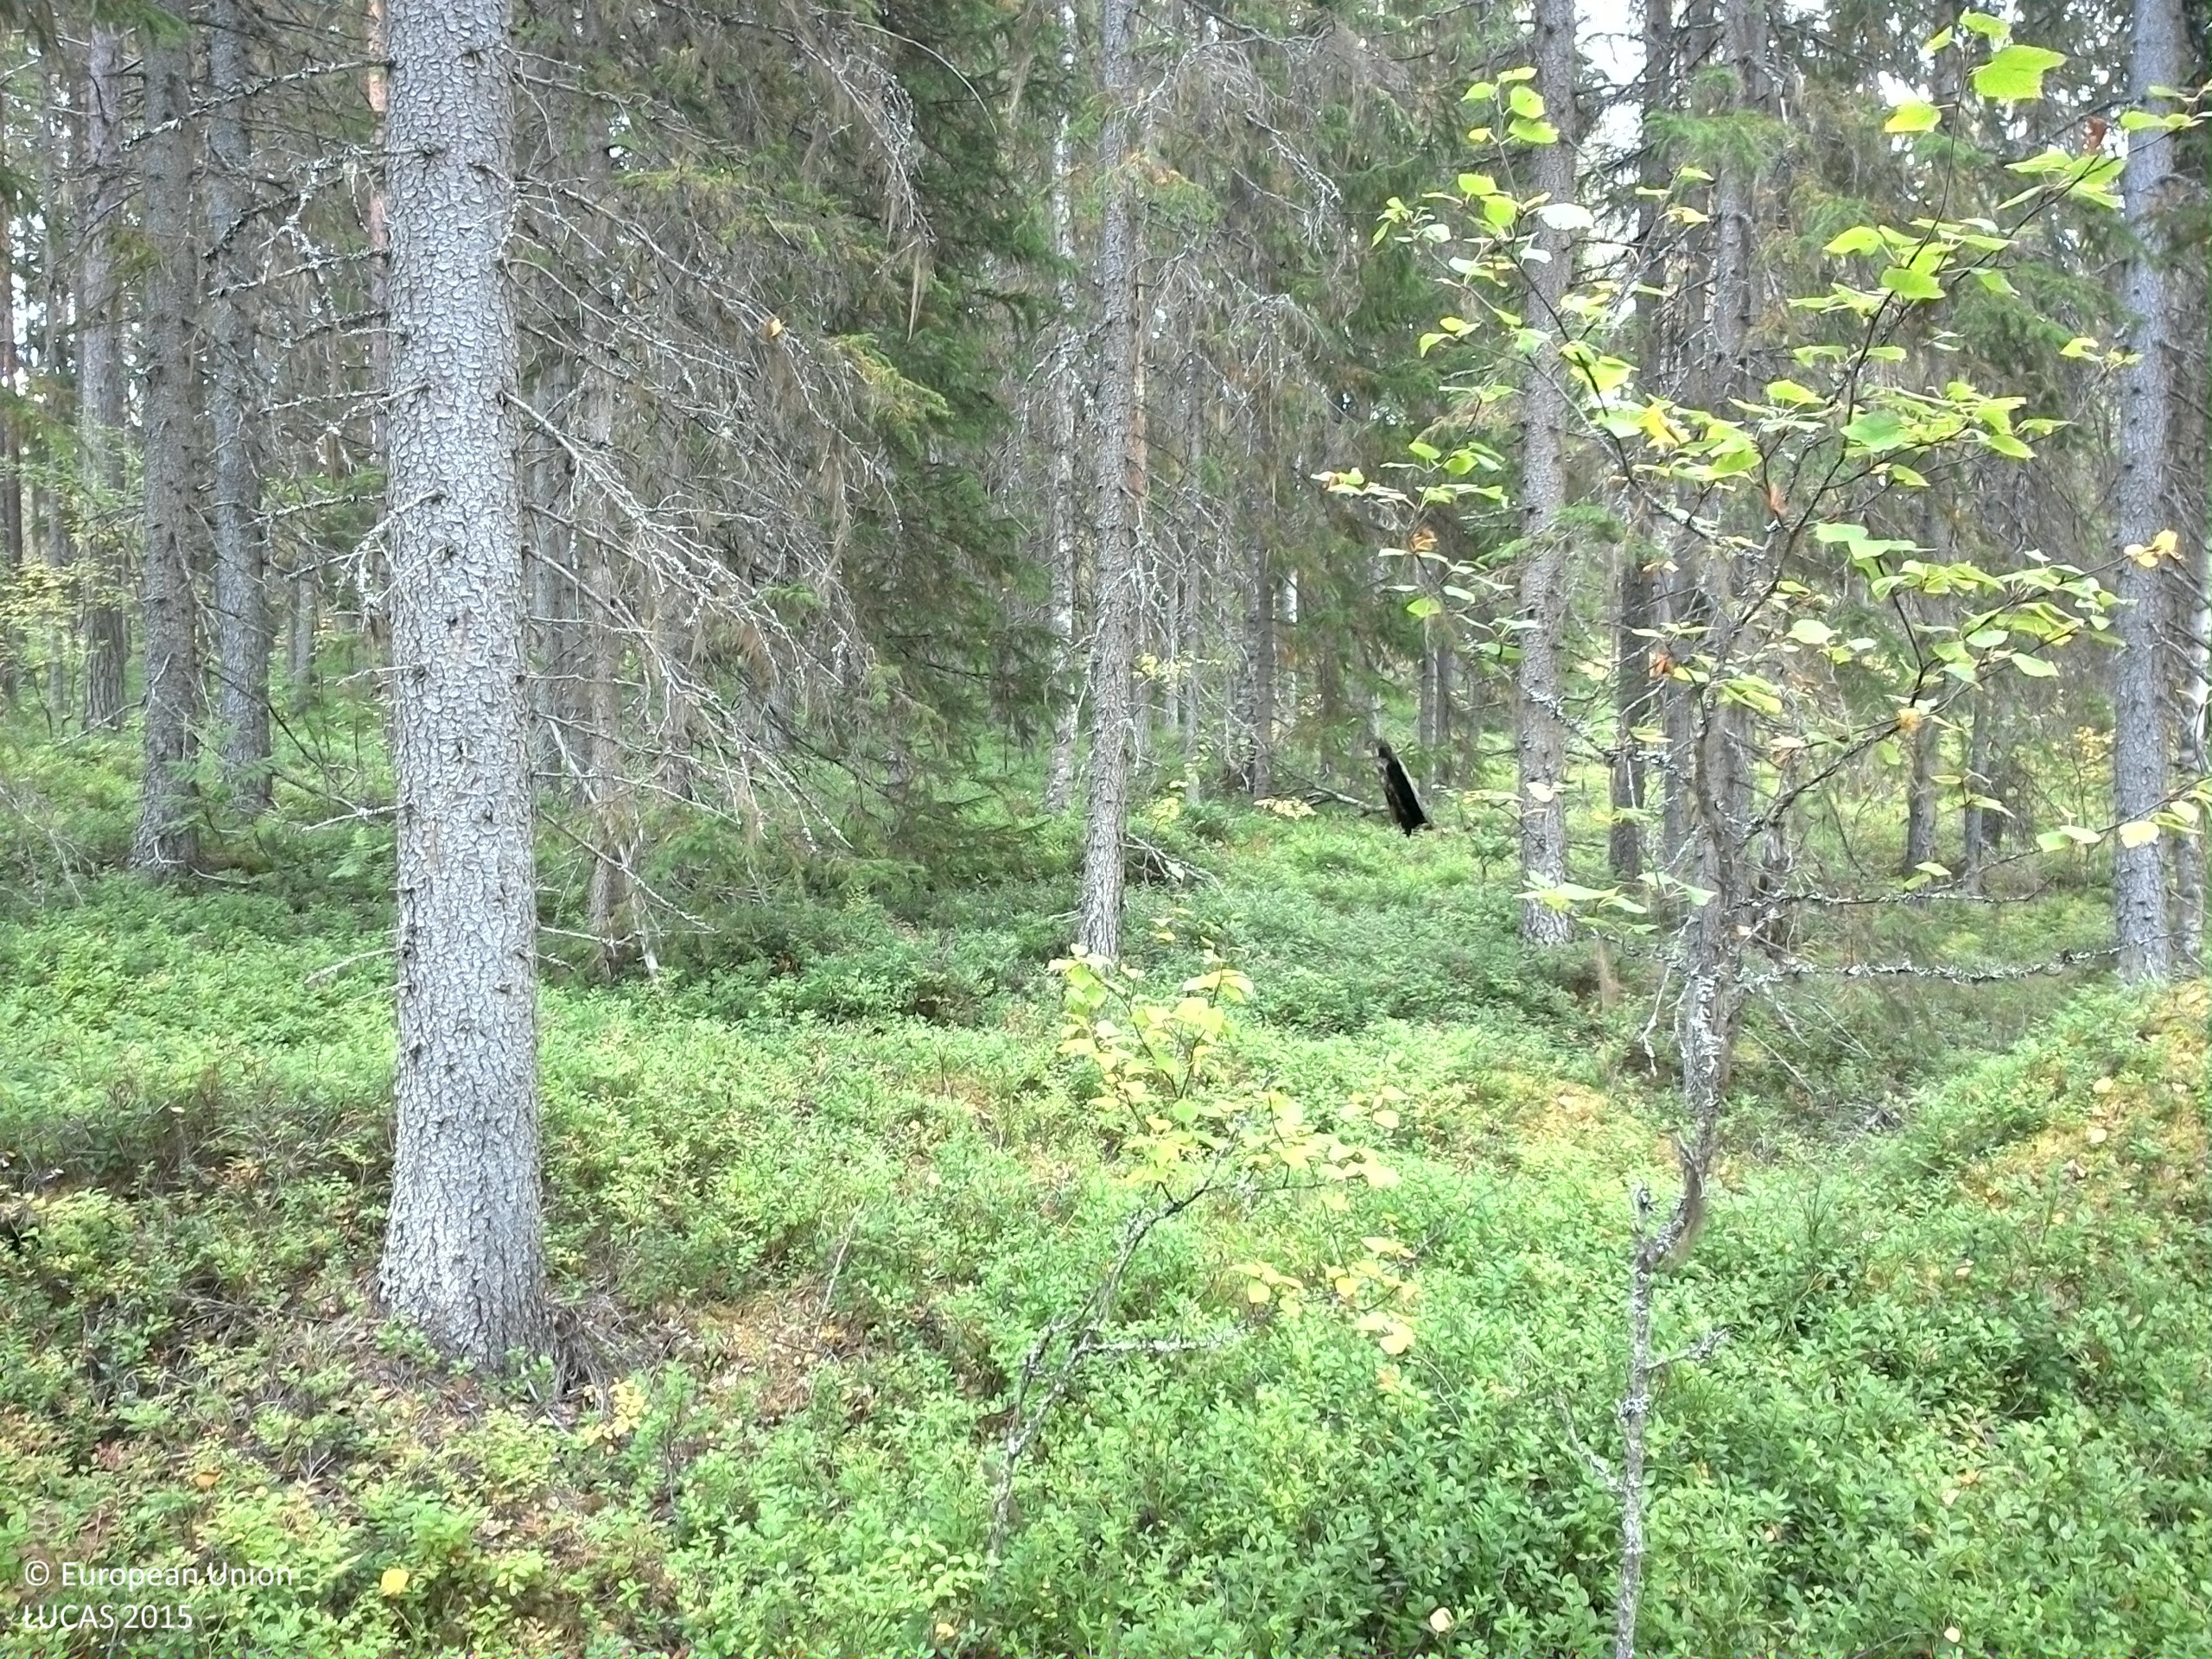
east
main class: Woodland
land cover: Spruce dominated mixed woodland
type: boreal forest
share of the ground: 50 - 75 %
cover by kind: coniferous forest trees 40 %, shrubs 35 %, broadleaved forest trees 15 %, lichens and mosses 10 %
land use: Forestry
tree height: > 5 m
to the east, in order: Spruce dominated mixed woodland; Pine dominated coniferous woodland; Broadleaved woodland; Paved roads, cycling and walking lanes; Ditches and canals; Pine dominated coniferous woodland
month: September
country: SE
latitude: 63.8662
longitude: 16.5036
